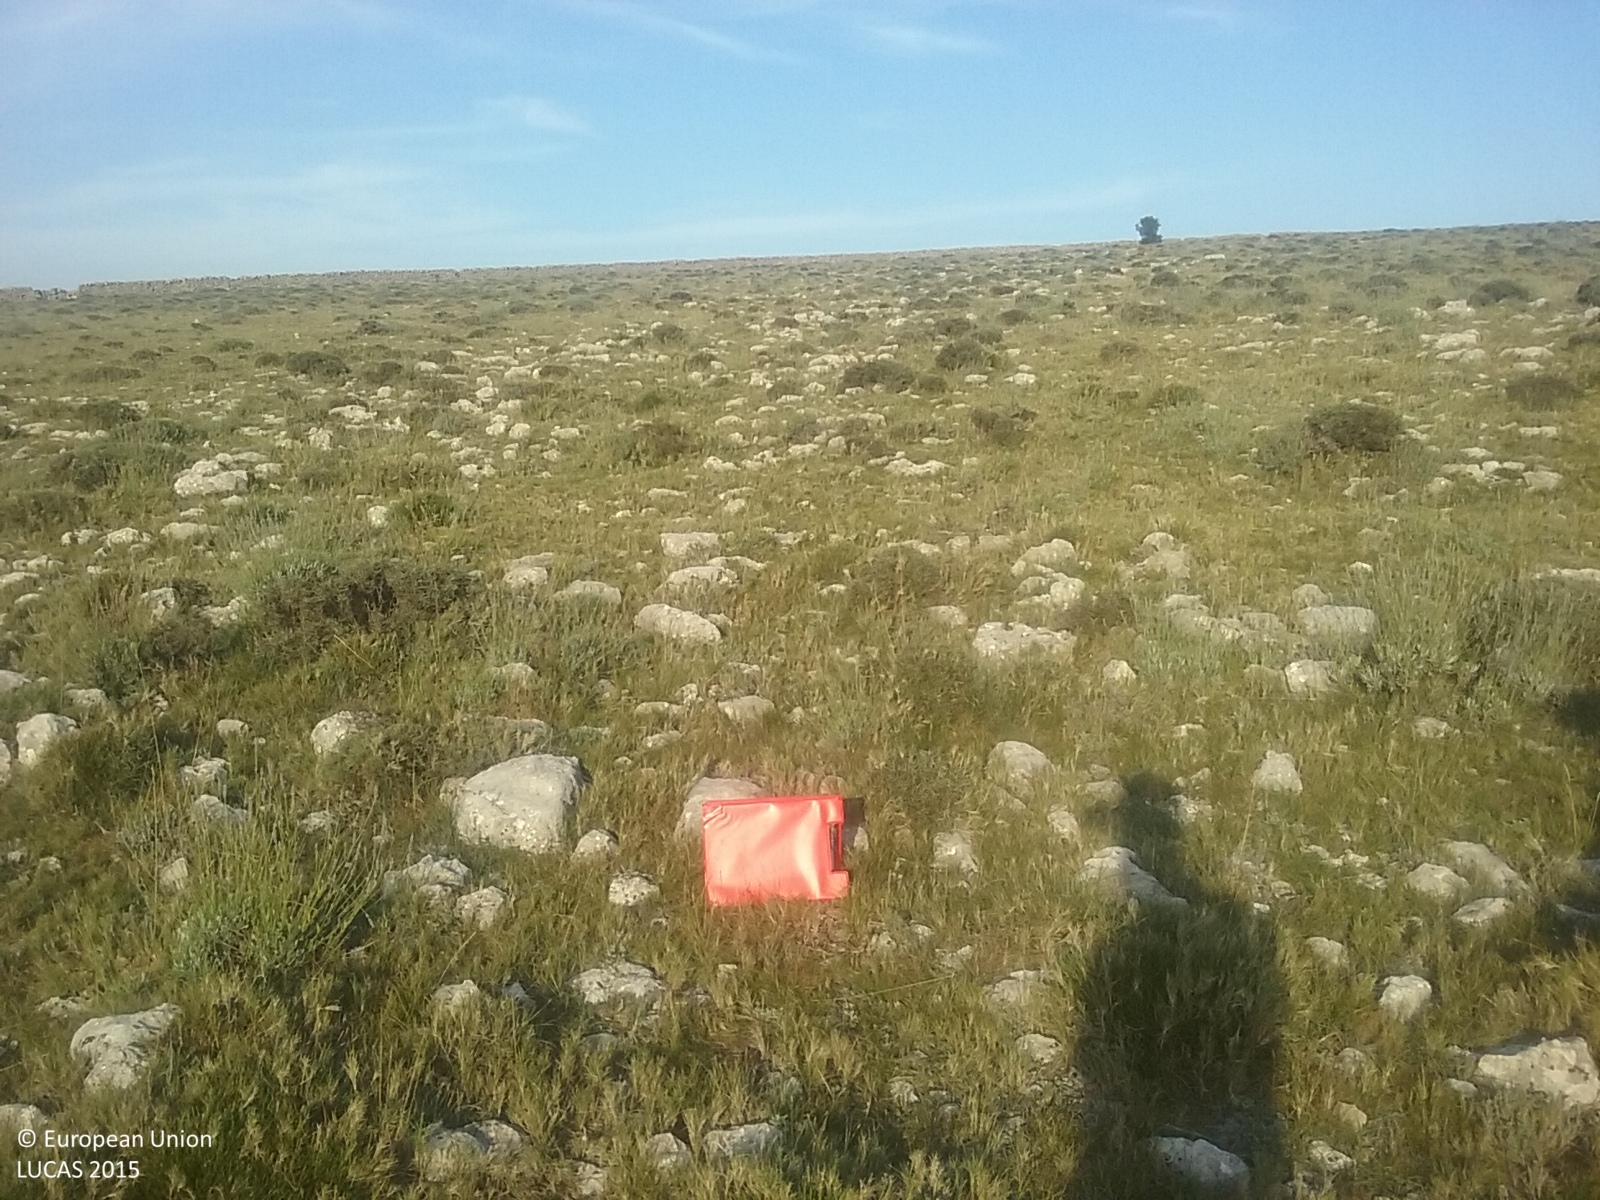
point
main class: Shrubland
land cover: Shrubland without tree cover
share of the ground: 25 - 50 %
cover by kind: herbaceous plants 75 %, shrubs 25 %
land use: Agriculture (excluding fallow land and kitchen gardens)
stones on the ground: 25 - 50 %
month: August
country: ES
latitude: 40.4972
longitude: -0.0471
